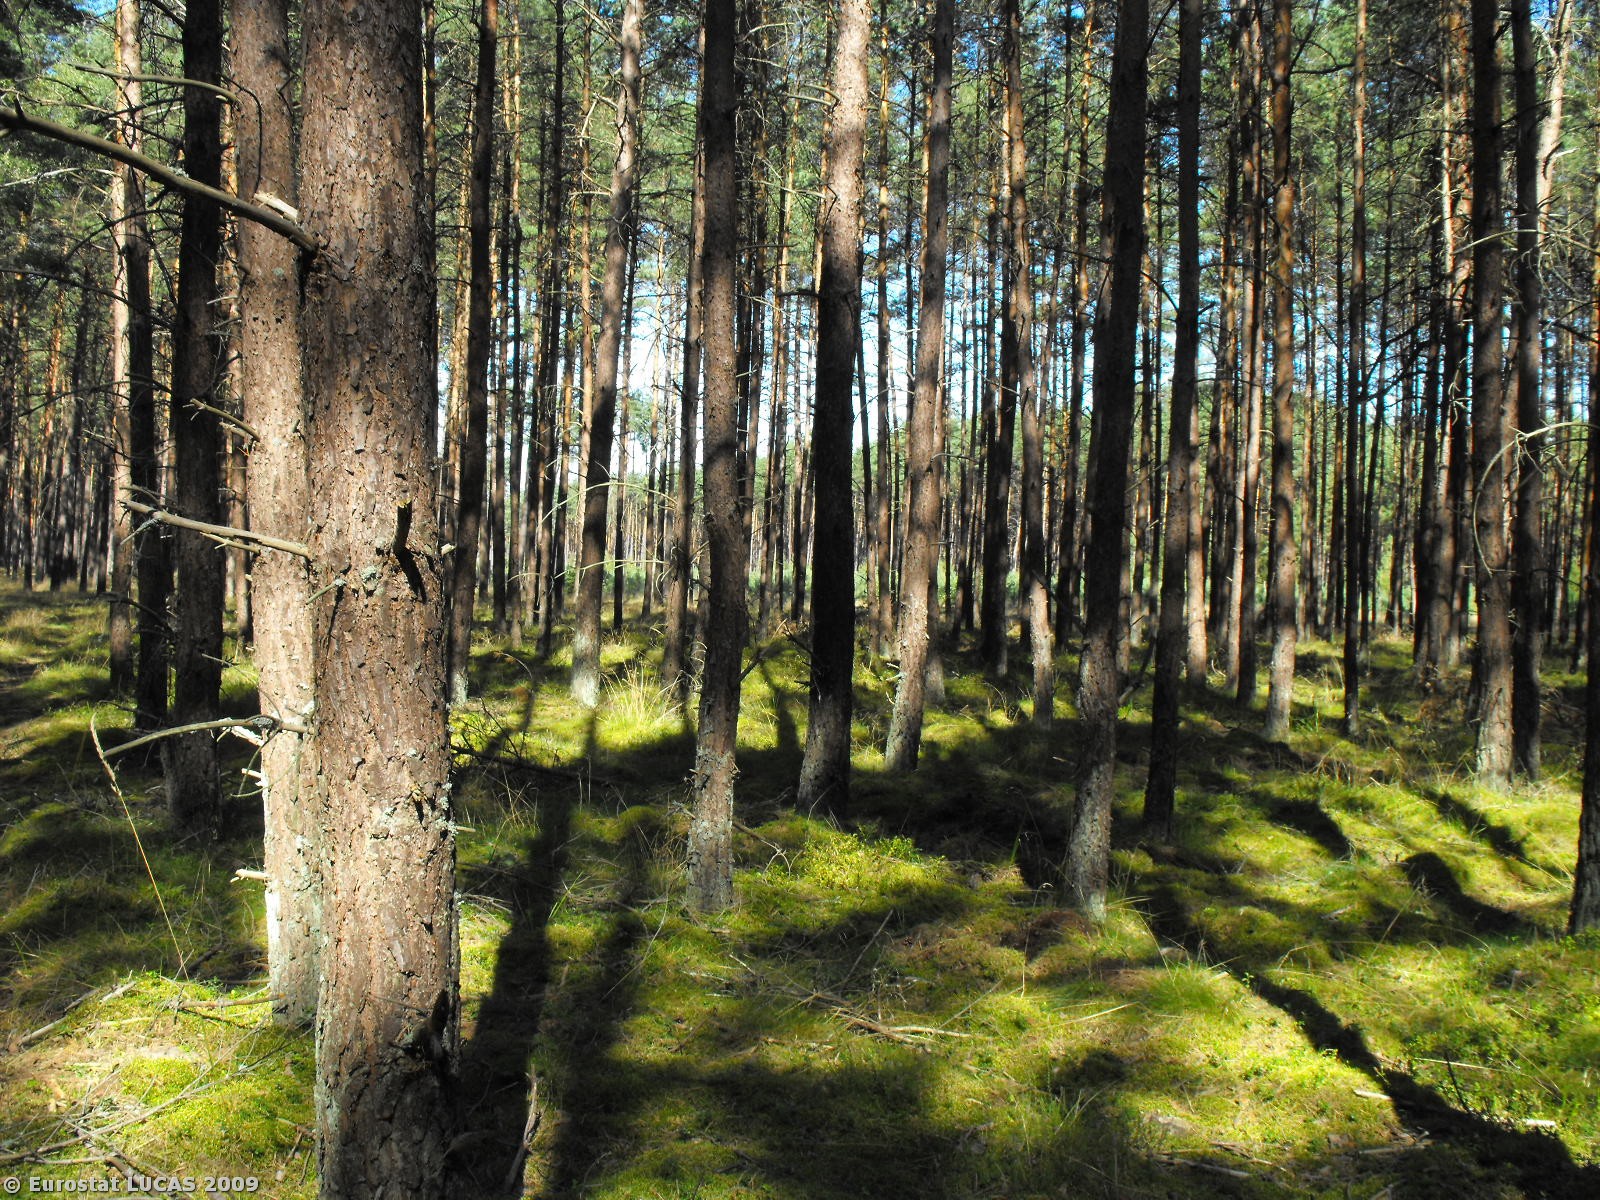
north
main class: Woodland
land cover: Coniferous woodland
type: hemiboreal forest and nemoral coniferous forest and mixed broadleaved-coniferous forest
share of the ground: > 75 %
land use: Forestry
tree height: > 5 m
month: September
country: PL
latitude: 53.4229
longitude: 16.5530
